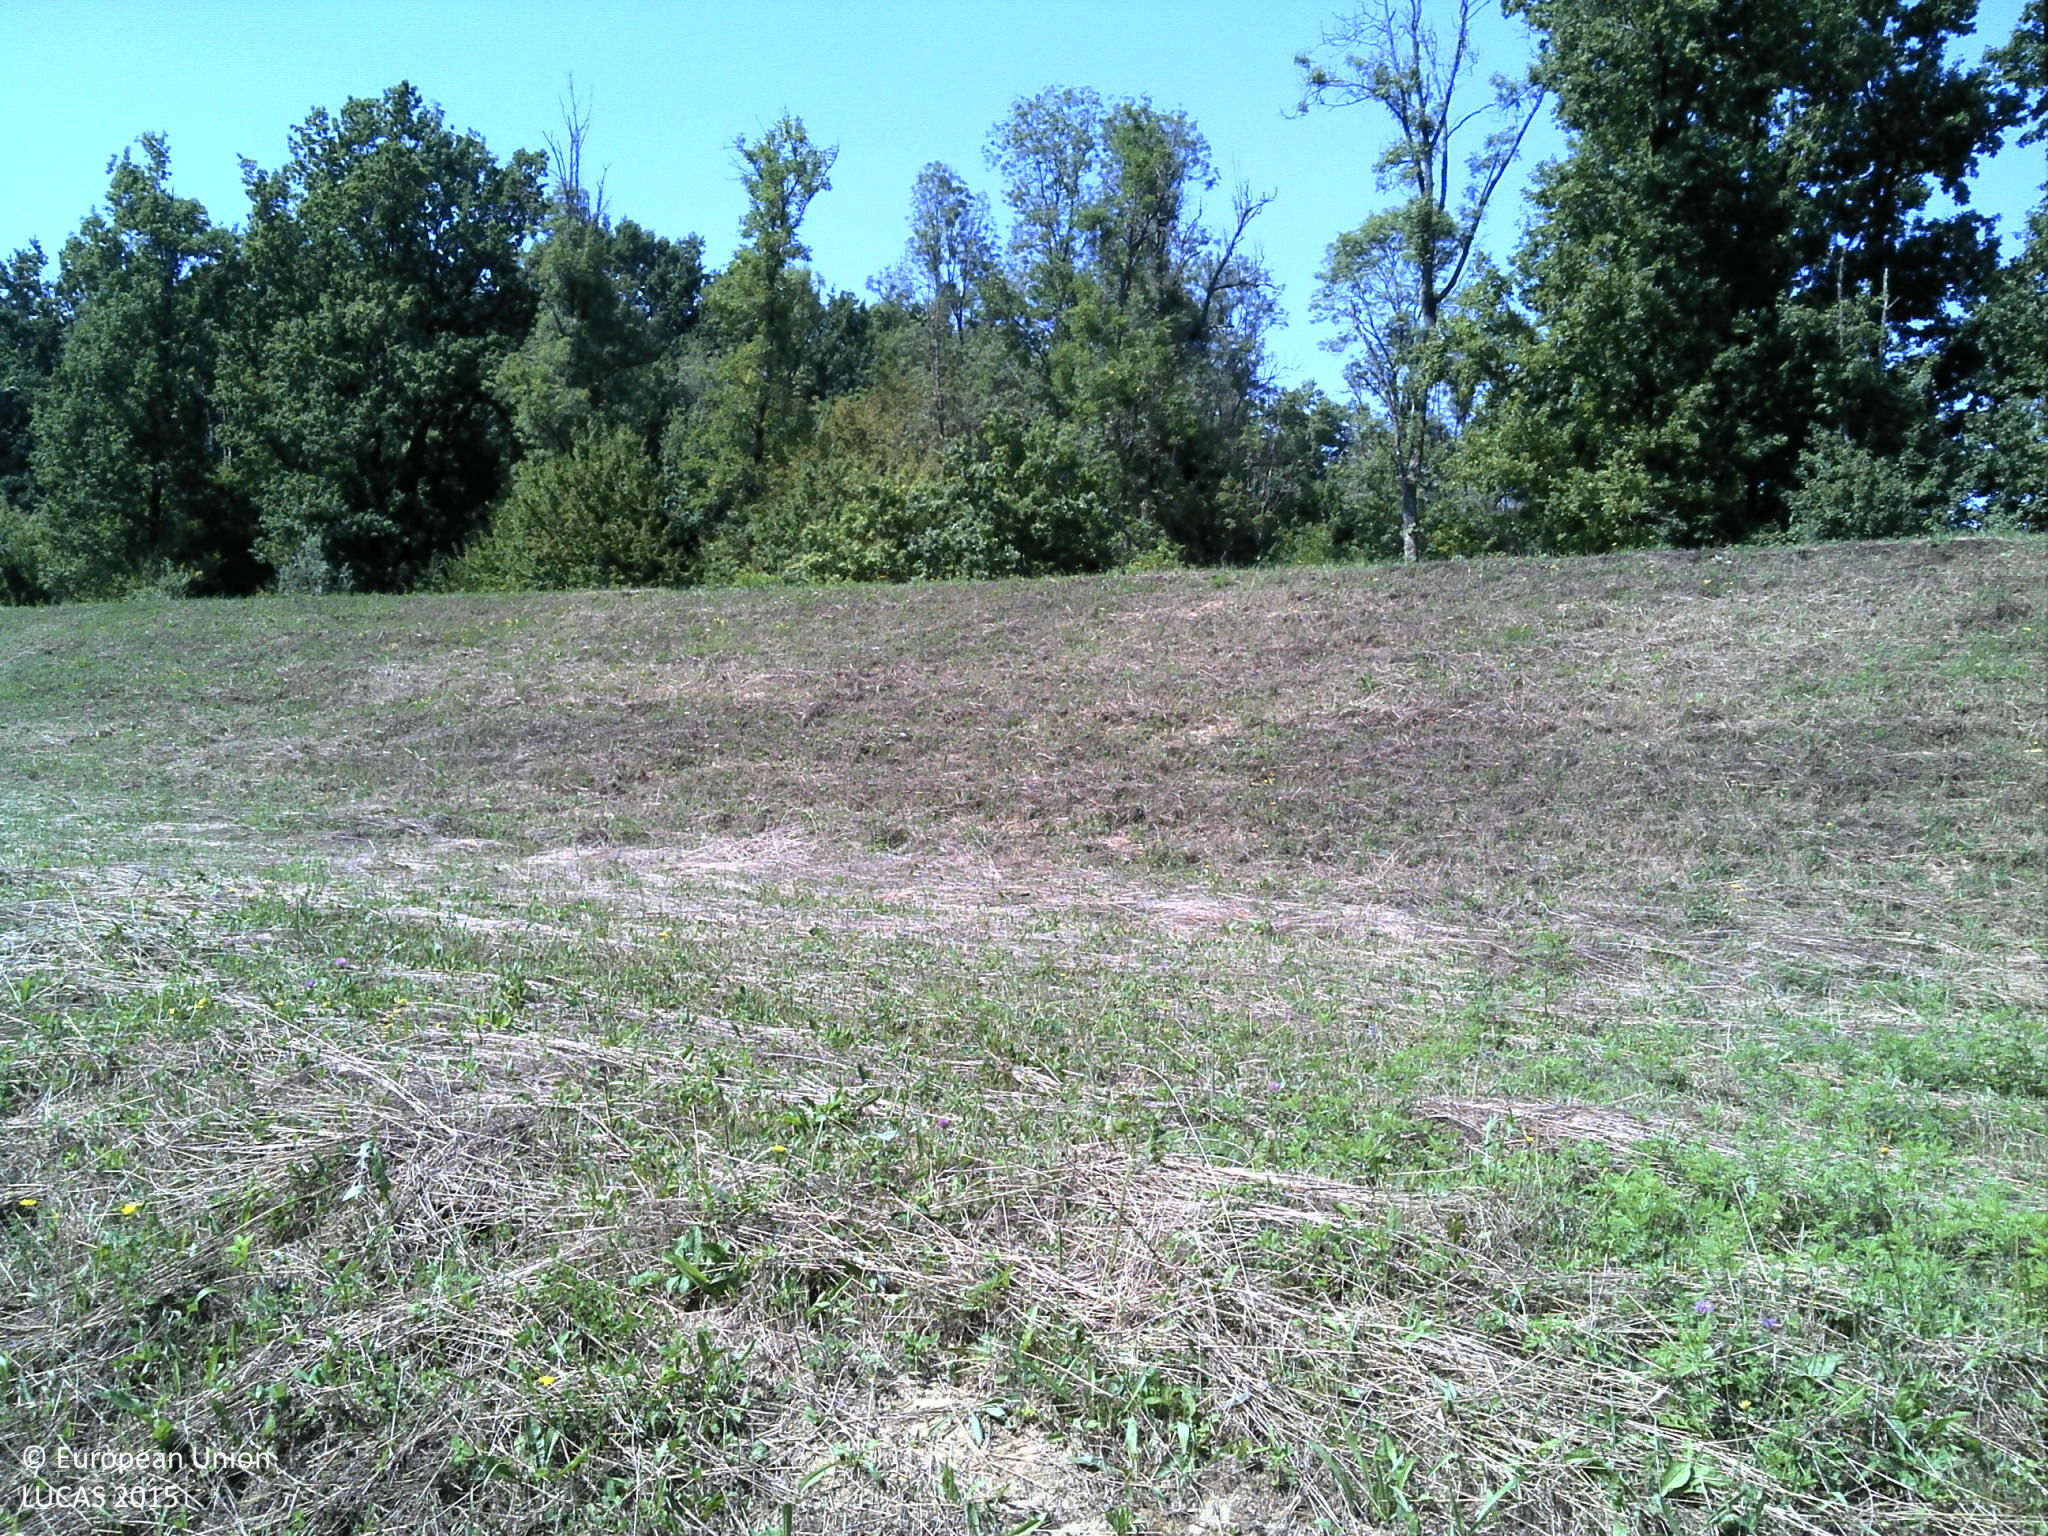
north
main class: Grassland
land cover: Grassland without tree/shrub cover
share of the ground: > 75 %
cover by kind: herbaceous plants 100 %
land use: Semi-natural and natural areas not in use
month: August
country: HR
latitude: 45.4810
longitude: 16.5613
